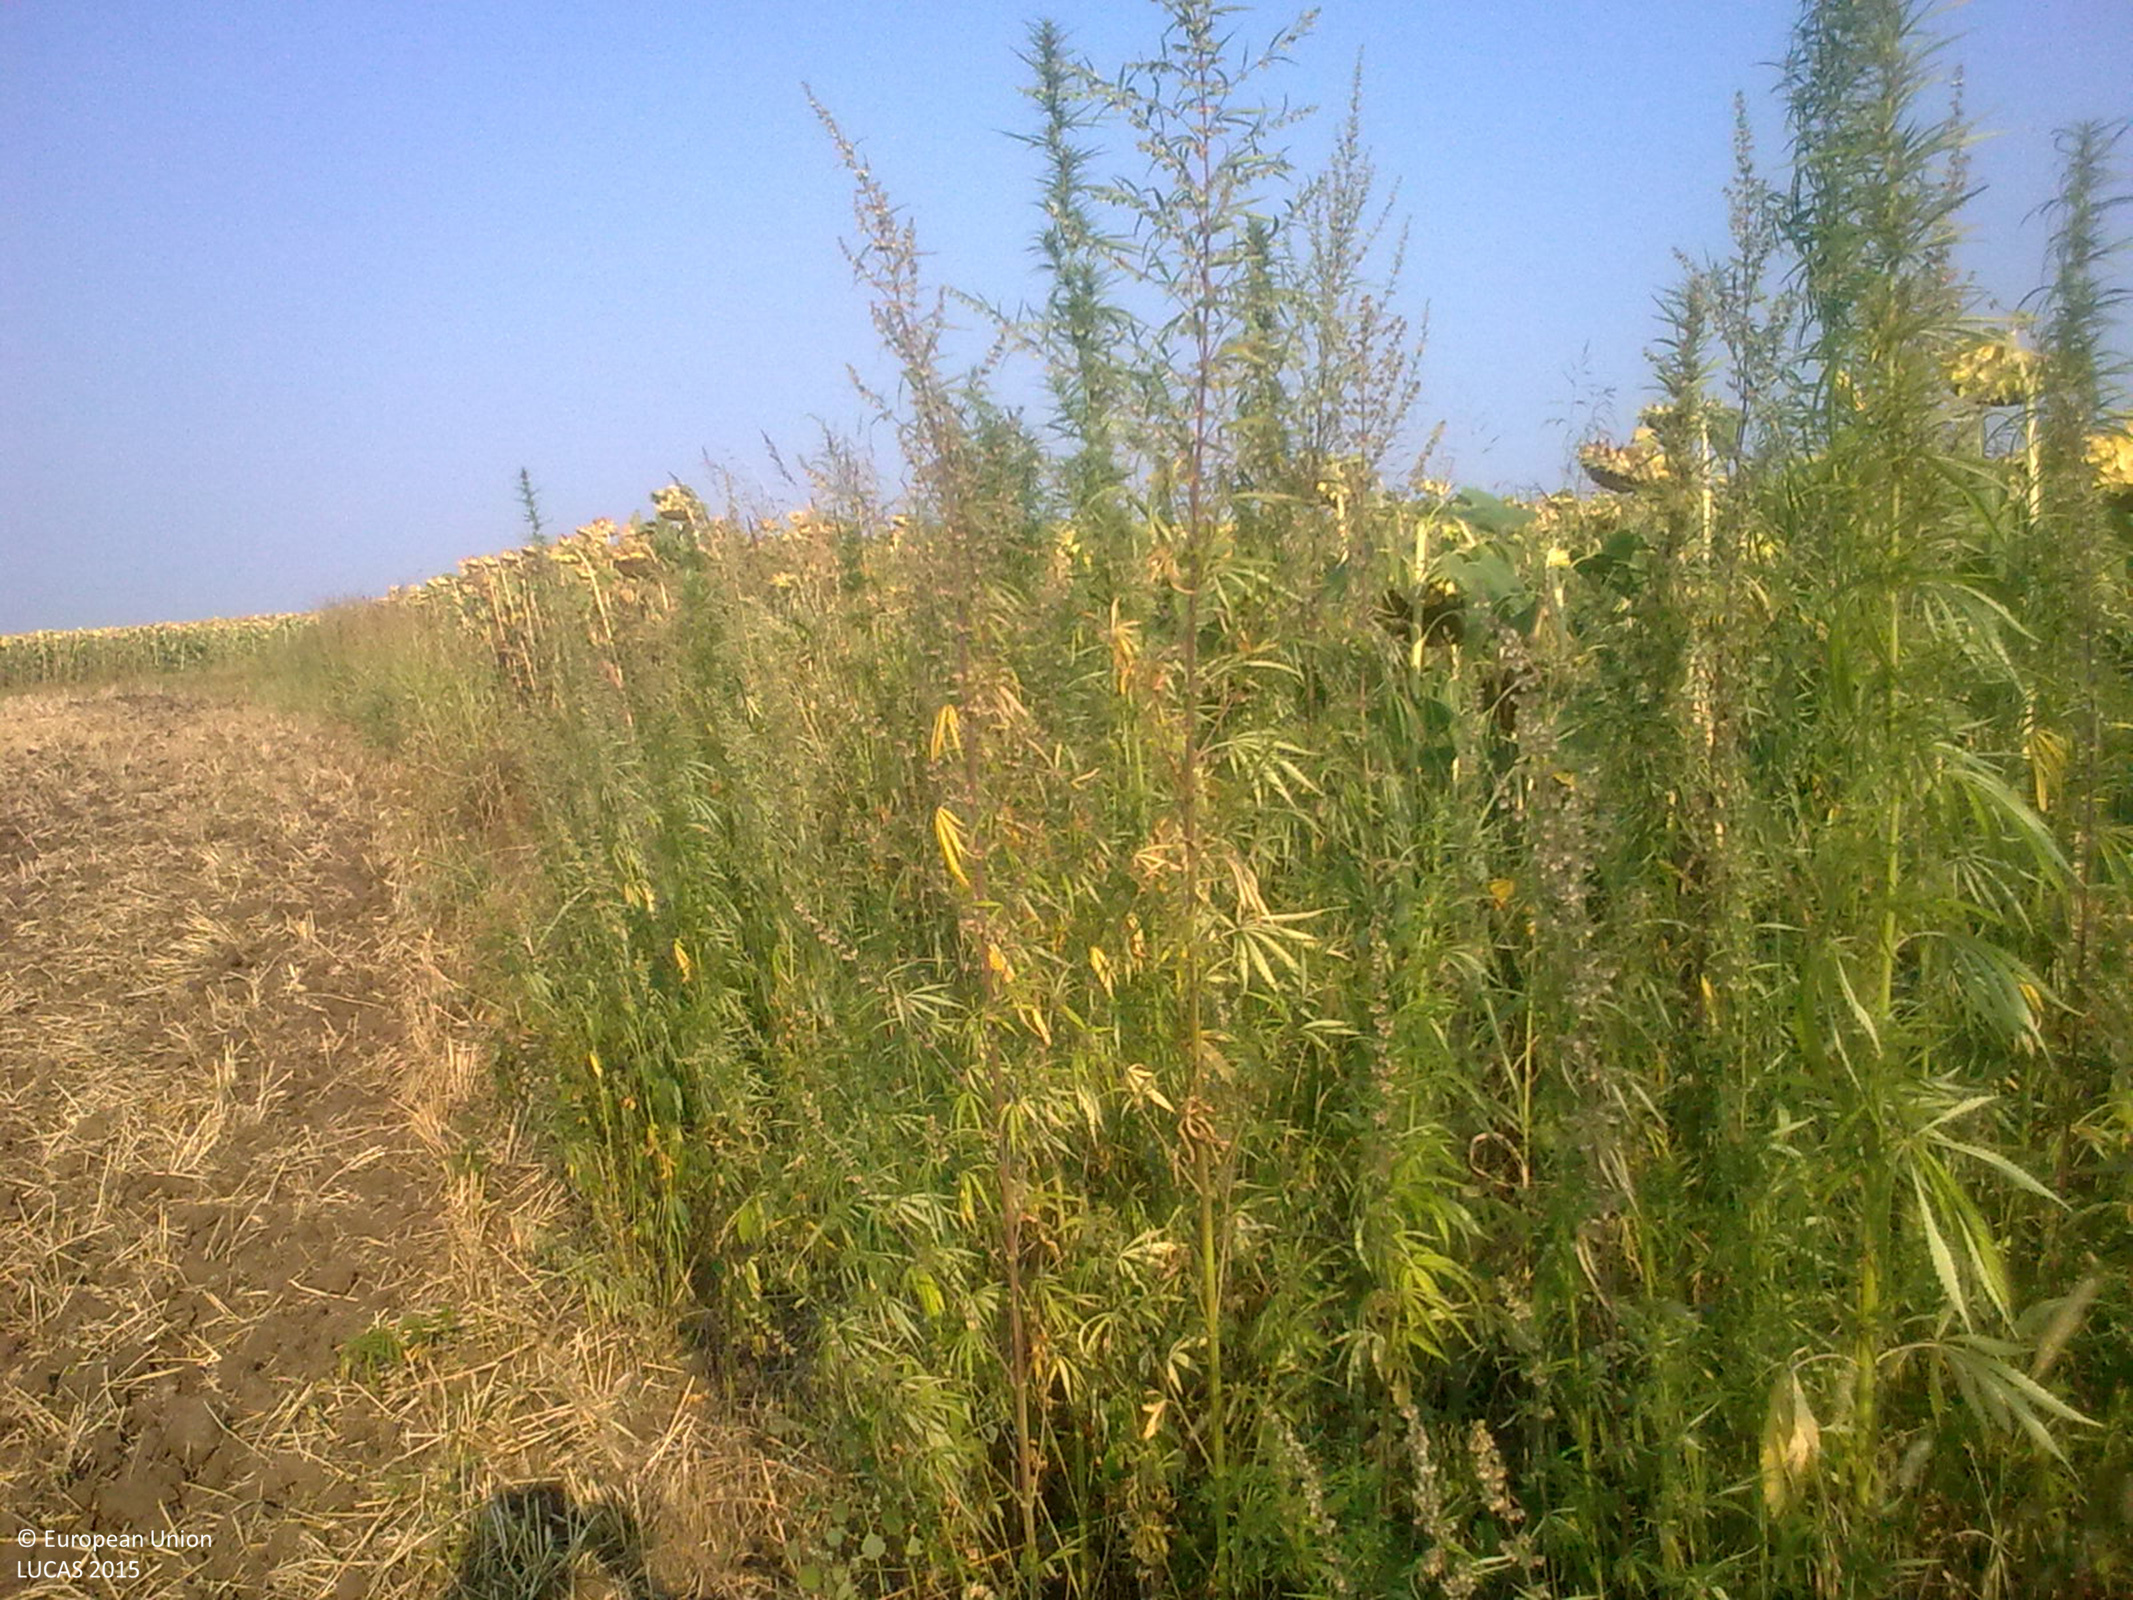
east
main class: Cropland
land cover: Sunflower
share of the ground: > 75 %
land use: Agriculture (excluding fallow land and kitchen gardens)
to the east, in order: Sunflower
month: July
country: BG
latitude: 43.4092
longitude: 25.3027
